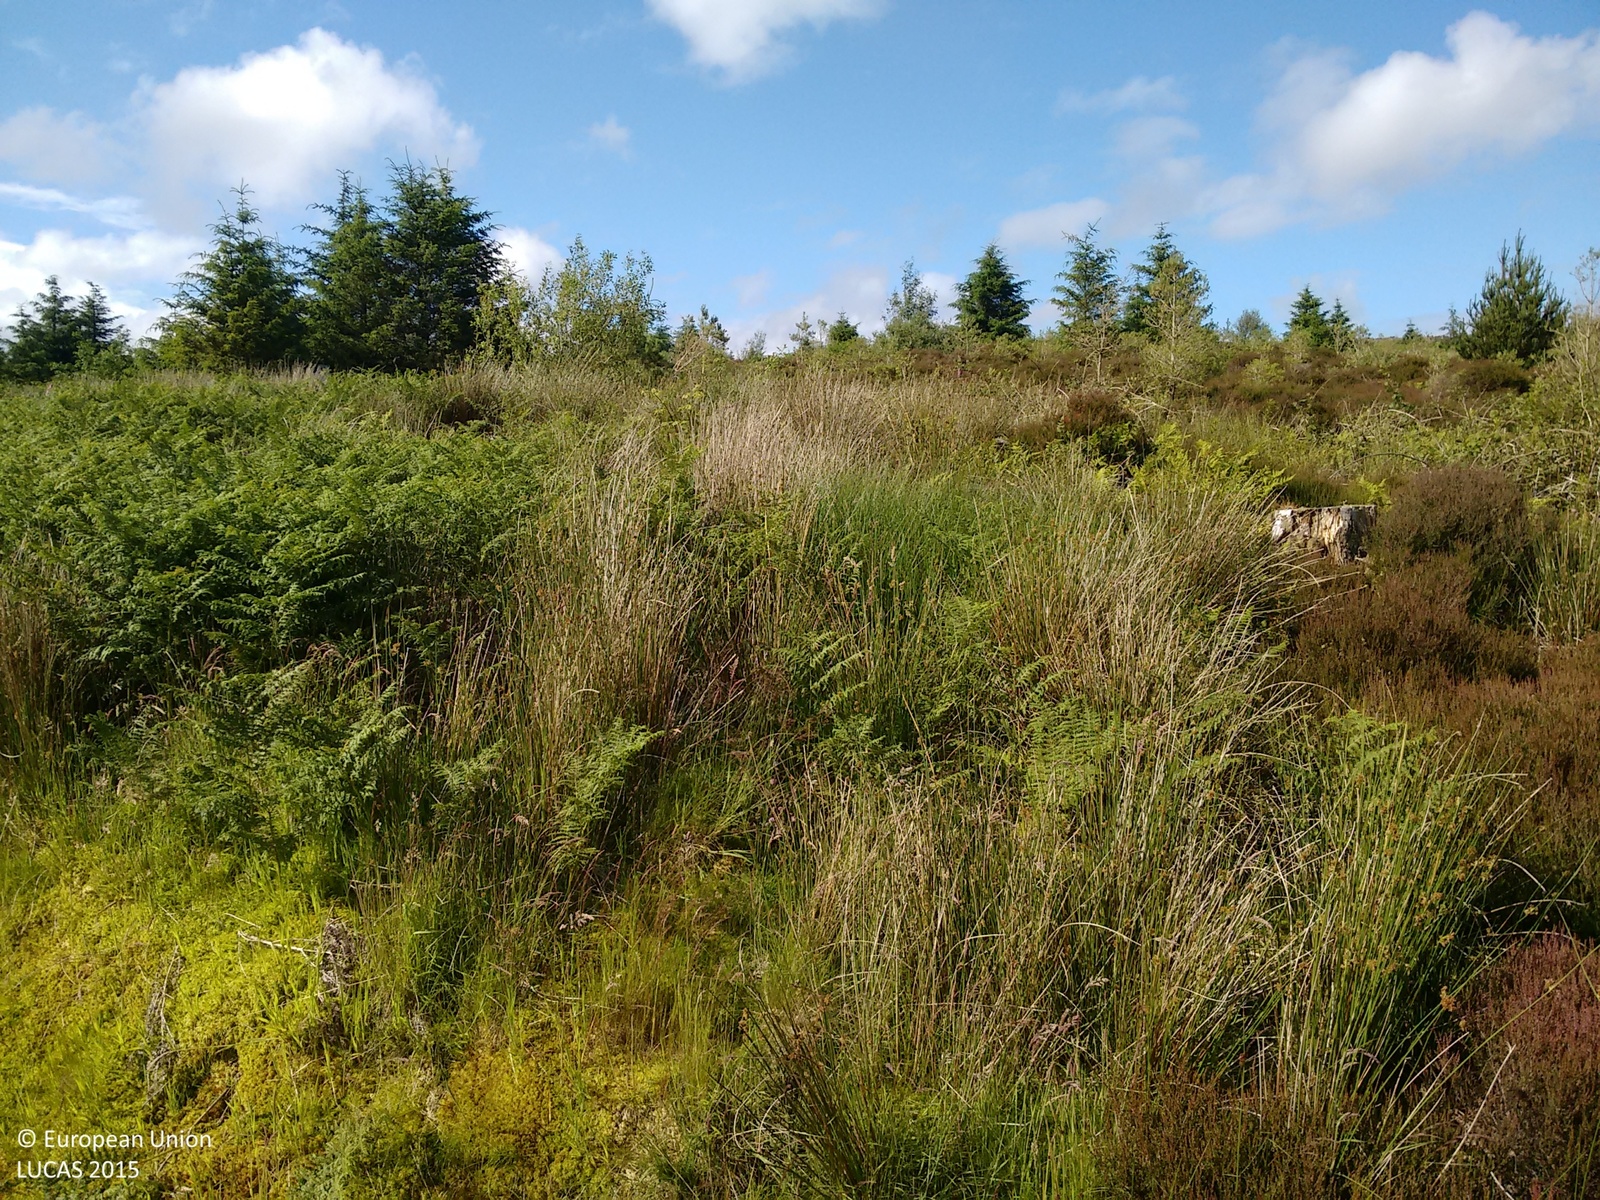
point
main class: Shrubland
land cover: Shrubland with sparse tree cover
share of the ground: > 75 %
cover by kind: shrubs 95 %, coniferous forest trees 5 %
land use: Semi-natural and natural areas not in use
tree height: < 5 m
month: July
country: GB
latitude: 55.4768
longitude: -5.1945
